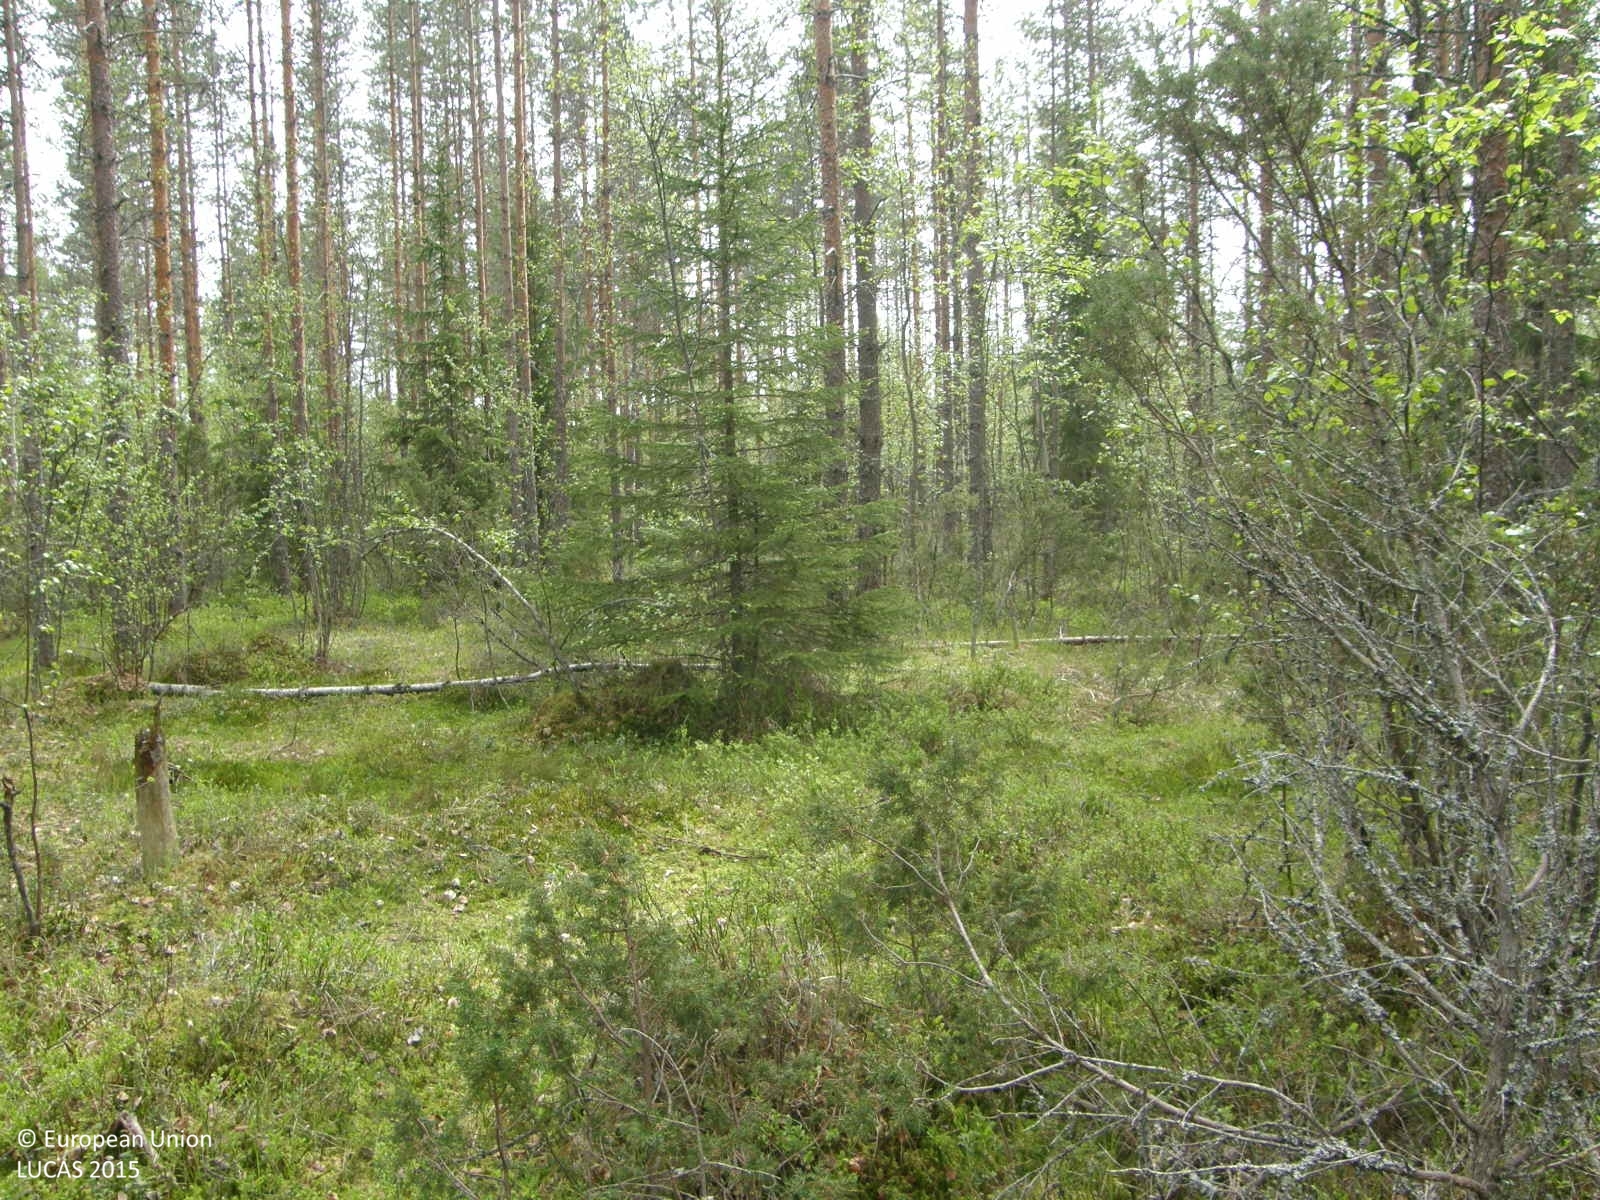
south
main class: Woodland
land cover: Pine dominated mixed woodland
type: boreal forest
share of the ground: > 75 %
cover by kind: coniferous forest trees 65 %, broadleaved forest trees 25 %, shrubs 10 %
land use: Forestry
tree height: > 5 m
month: June
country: FI
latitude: 62.1028
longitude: 22.3371
